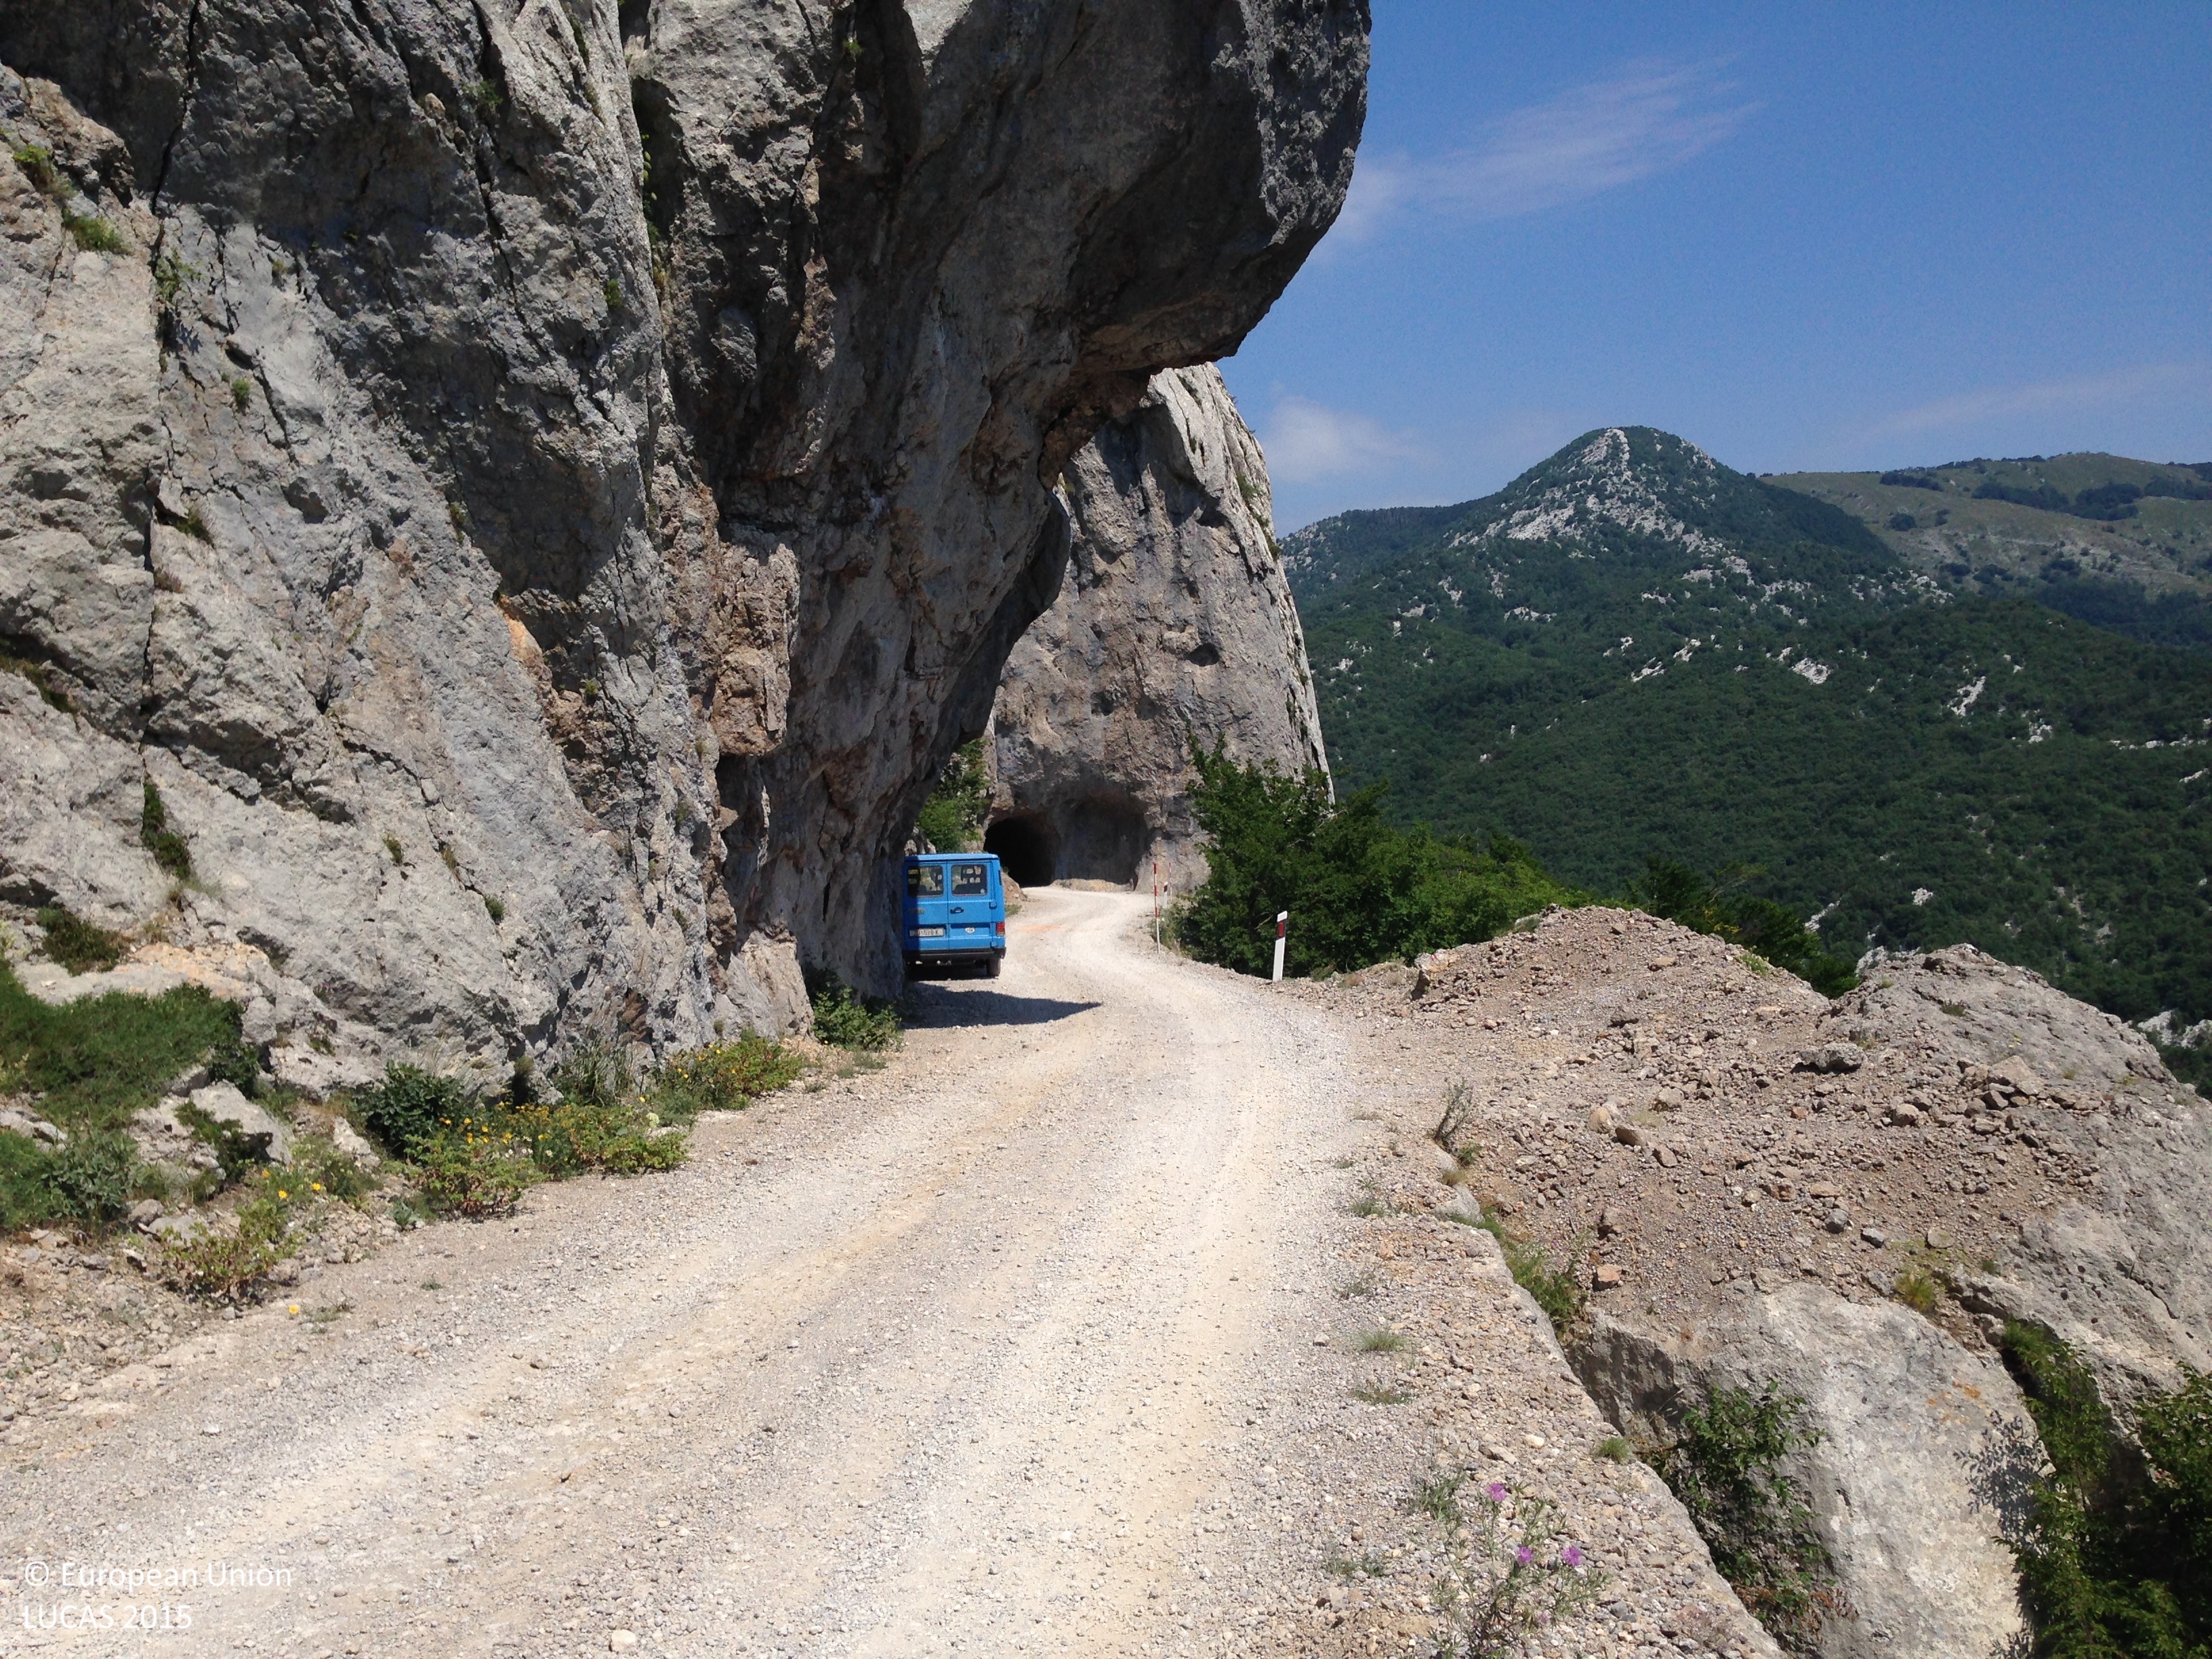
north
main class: Woodland
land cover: Broadleaved woodland
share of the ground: 10 - 25 %
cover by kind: consolidated bare surface 70 %, broadleaved forest trees 20 %, shrubs 10 %
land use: Semi-natural and natural areas not in use
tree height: > 5 m
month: July
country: HR
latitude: 44.5676
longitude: 15.1180
